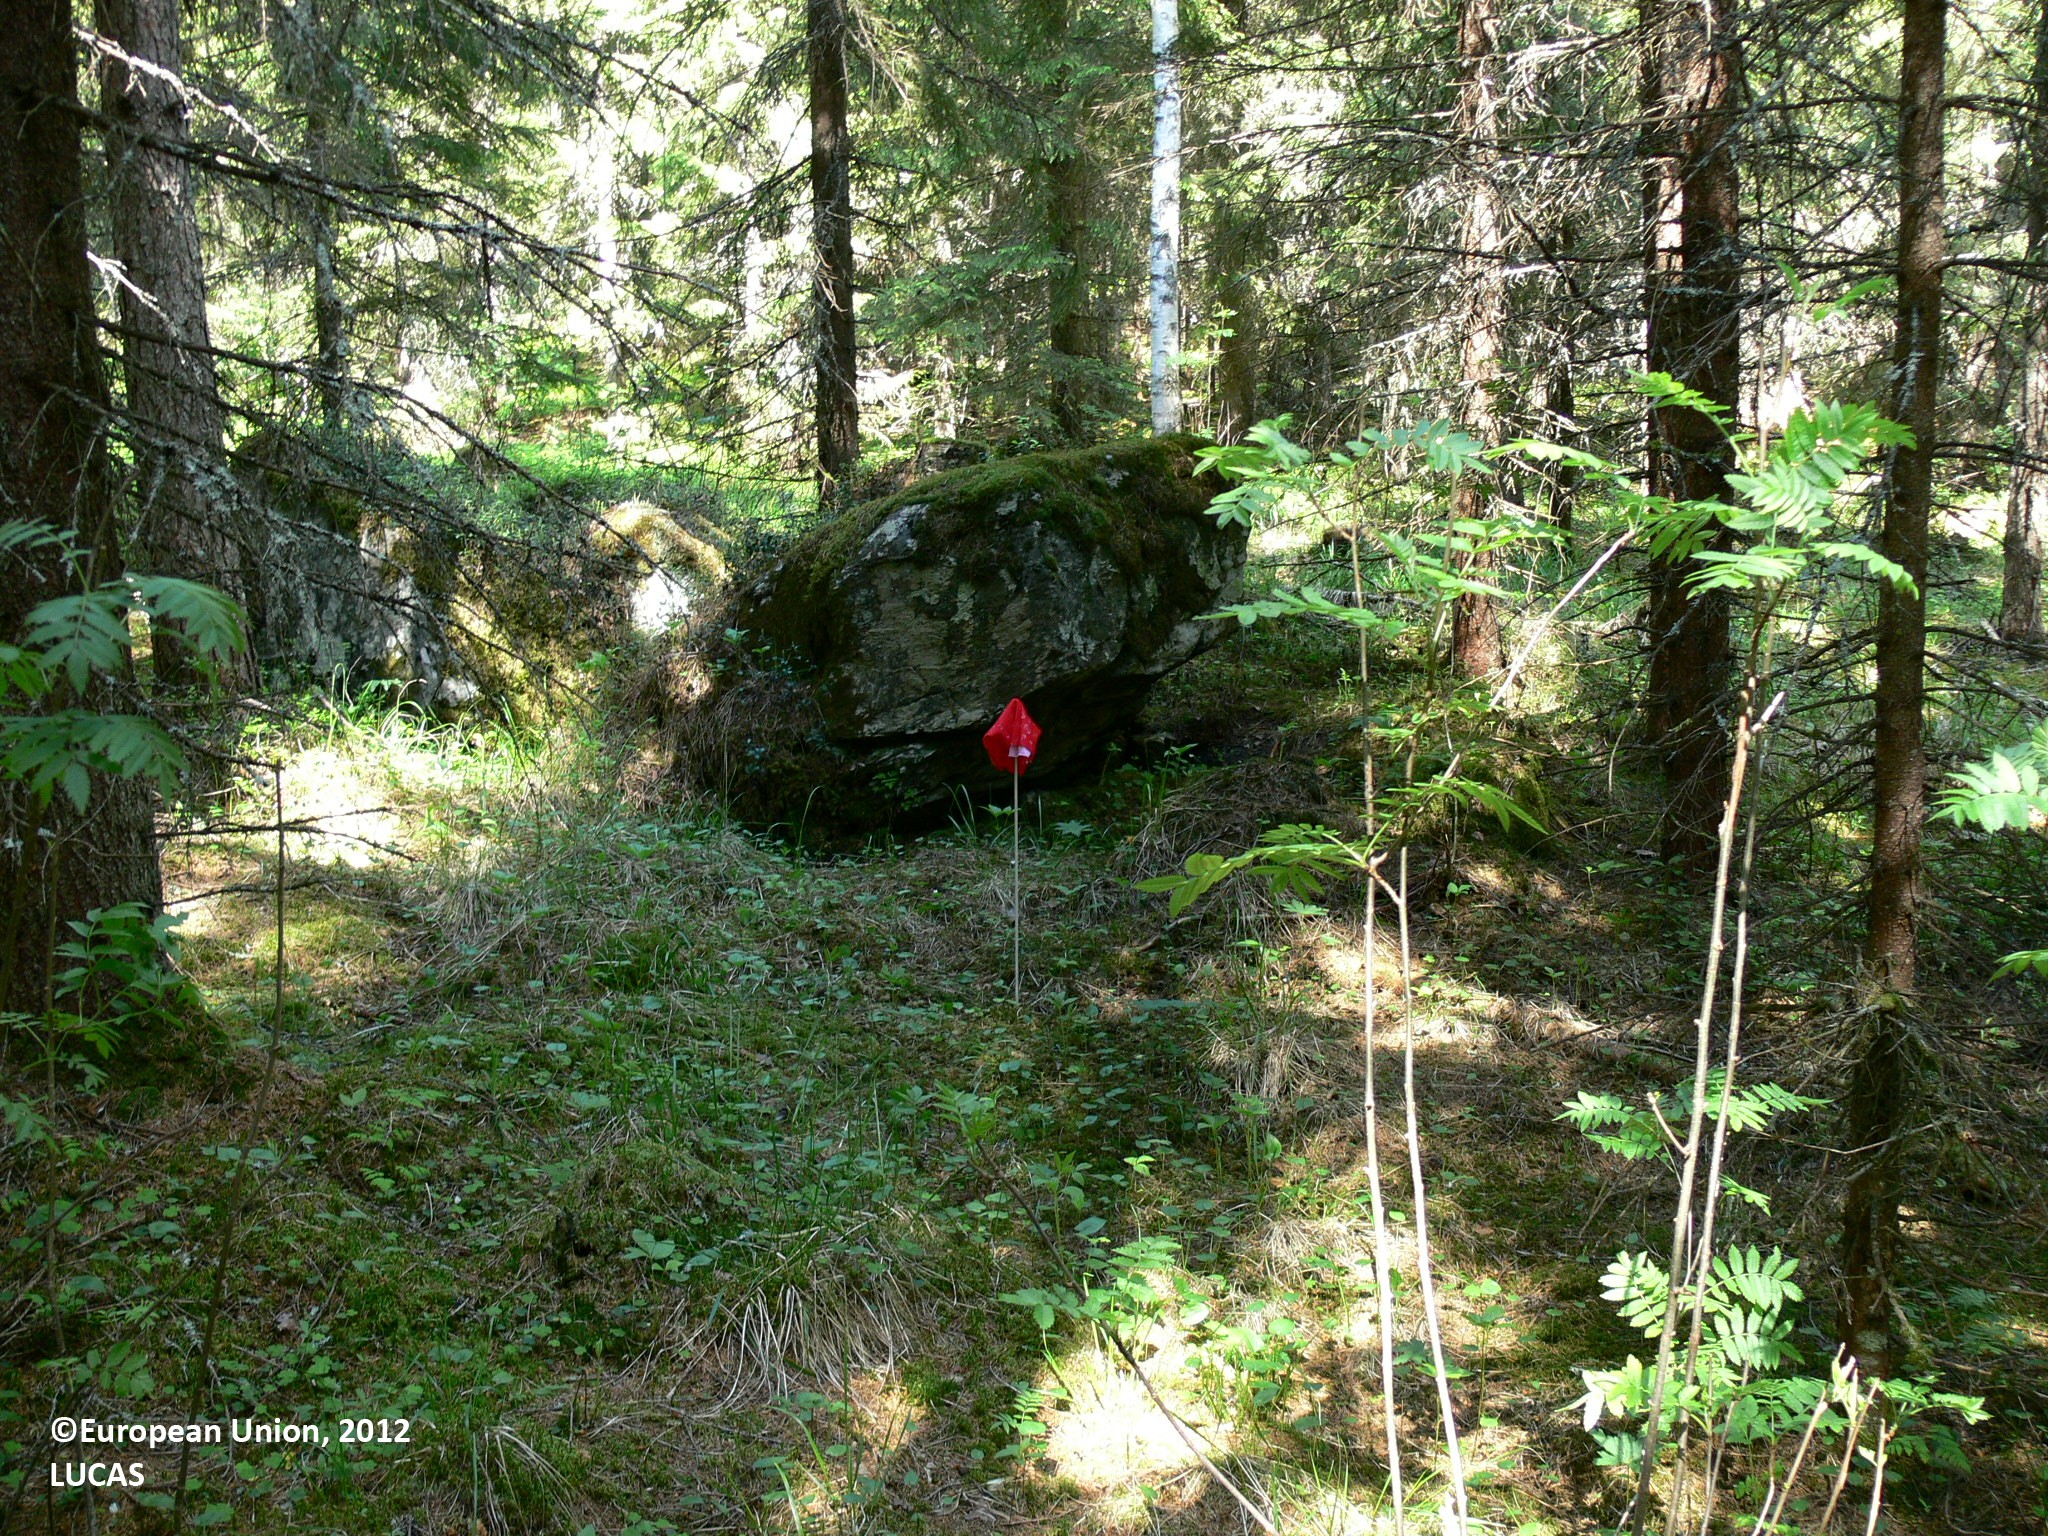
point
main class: Woodland
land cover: Spruce dominated coniferous woodland
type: boreal forest
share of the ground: > 75 %
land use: Forestry
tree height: > 5 m
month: June
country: FI
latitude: 62.5798
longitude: 30.3832
